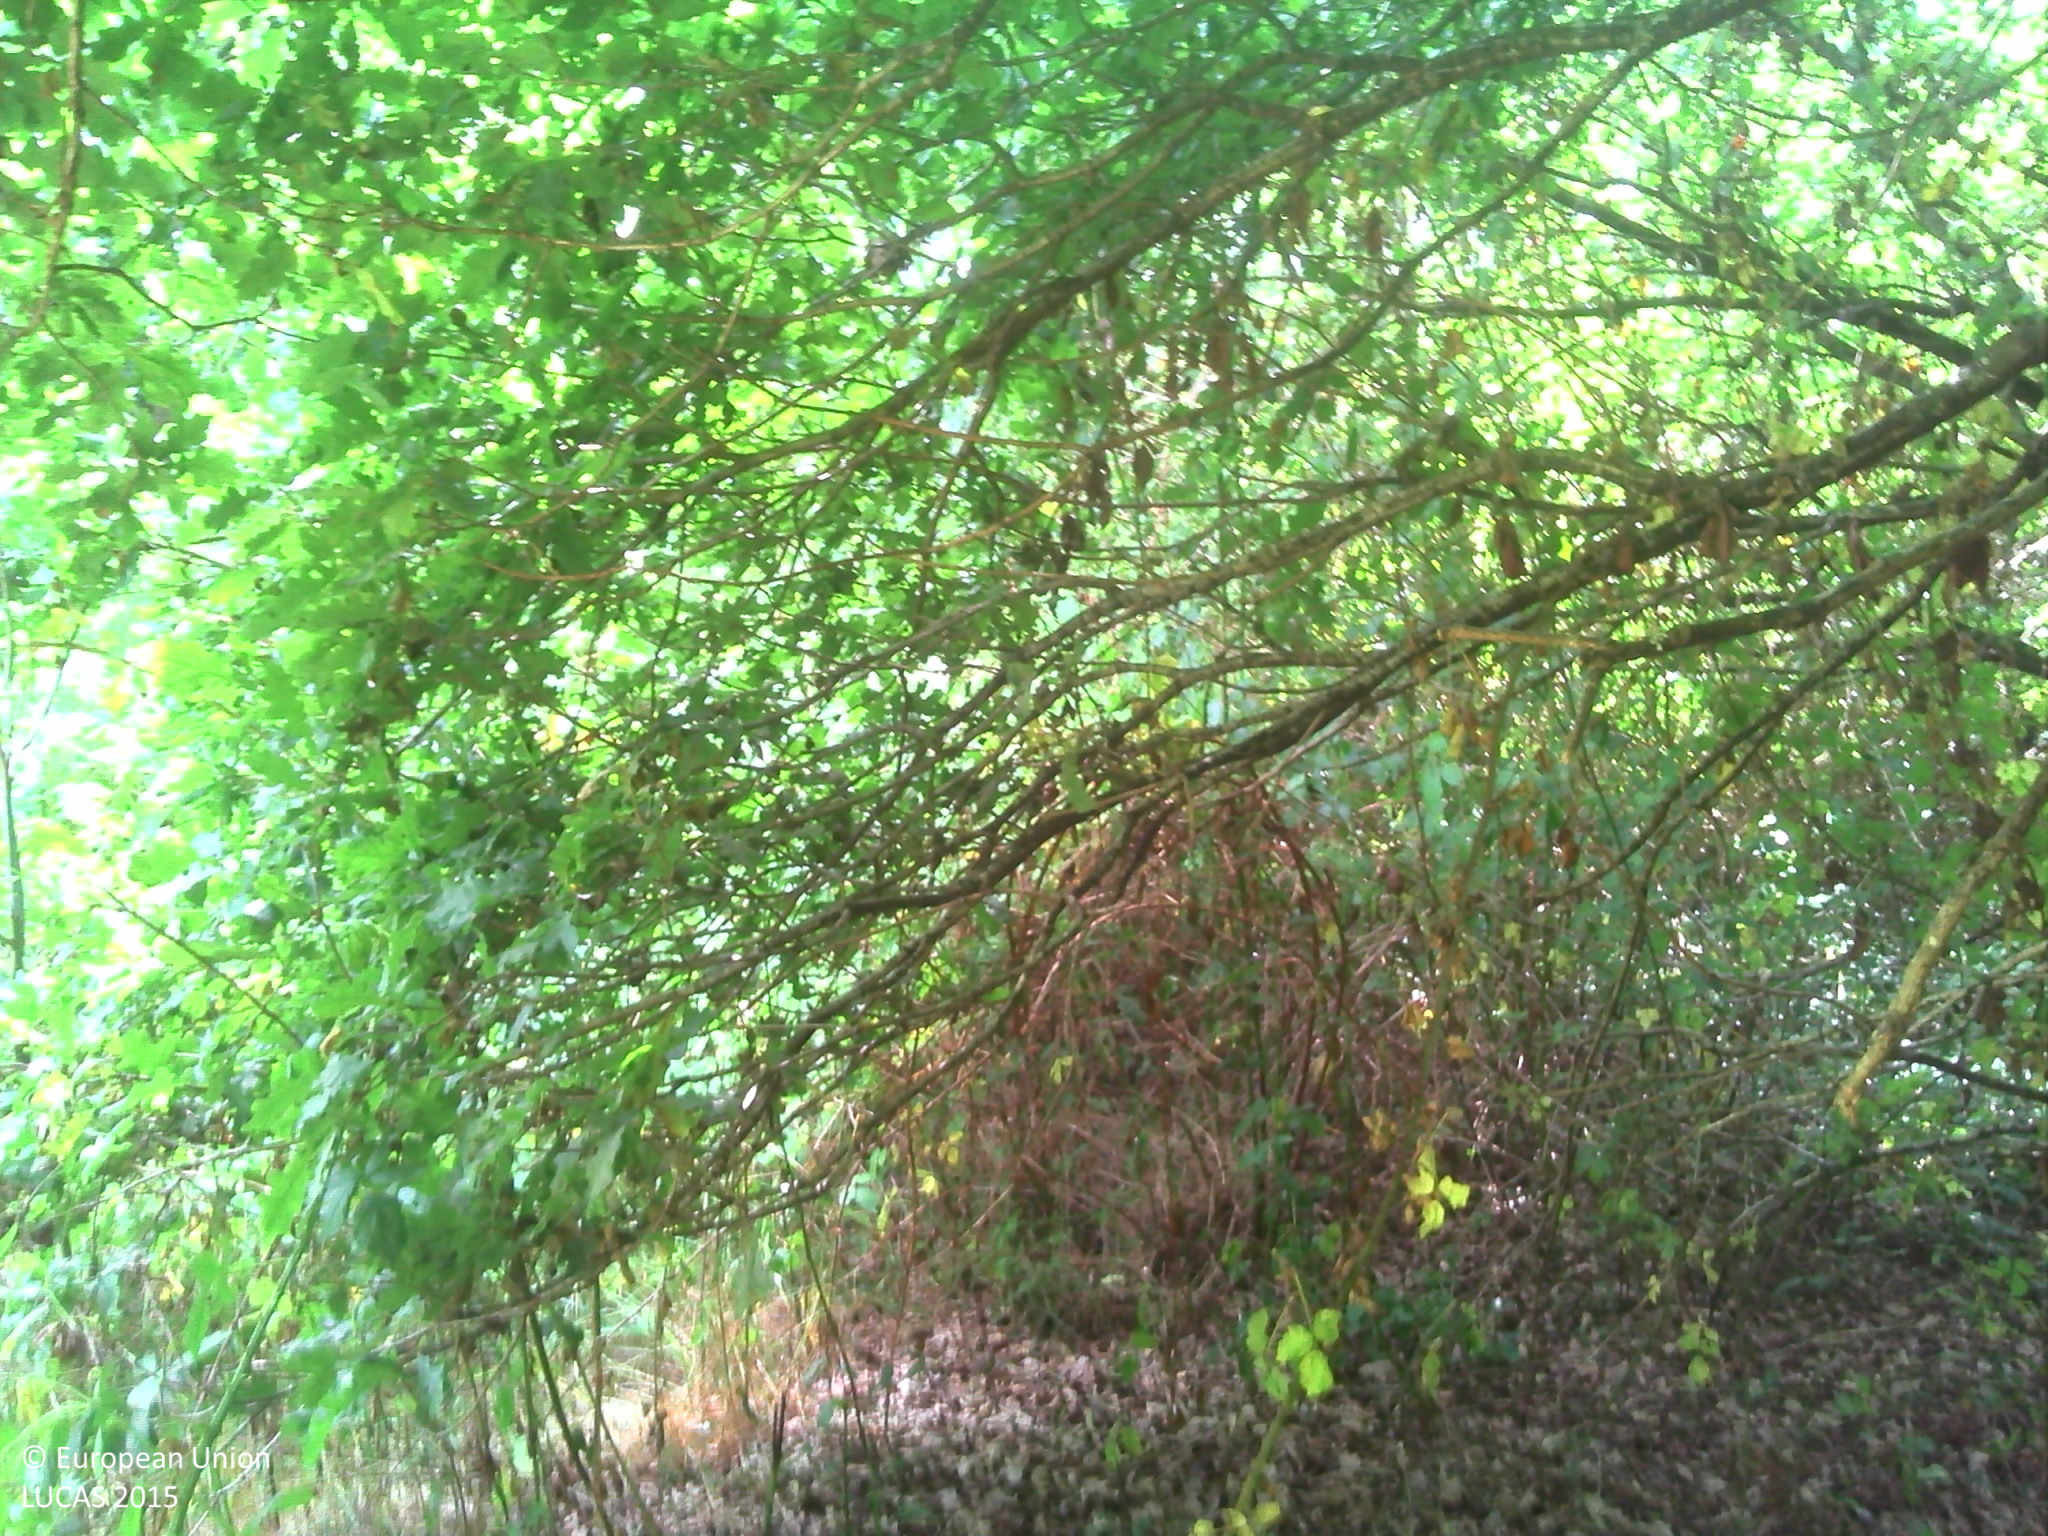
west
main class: Woodland
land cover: Broadleaved woodland
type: mesophytic deciduous forest
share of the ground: > 75 %
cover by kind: herbaceous plants 40 %, unconsolidated bare surface 40 %, broadleaved forest trees 20 %
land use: Forestry
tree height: > 5 m
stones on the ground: < 10 %
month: June
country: FR
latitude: 47.4372
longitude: 1.4336
